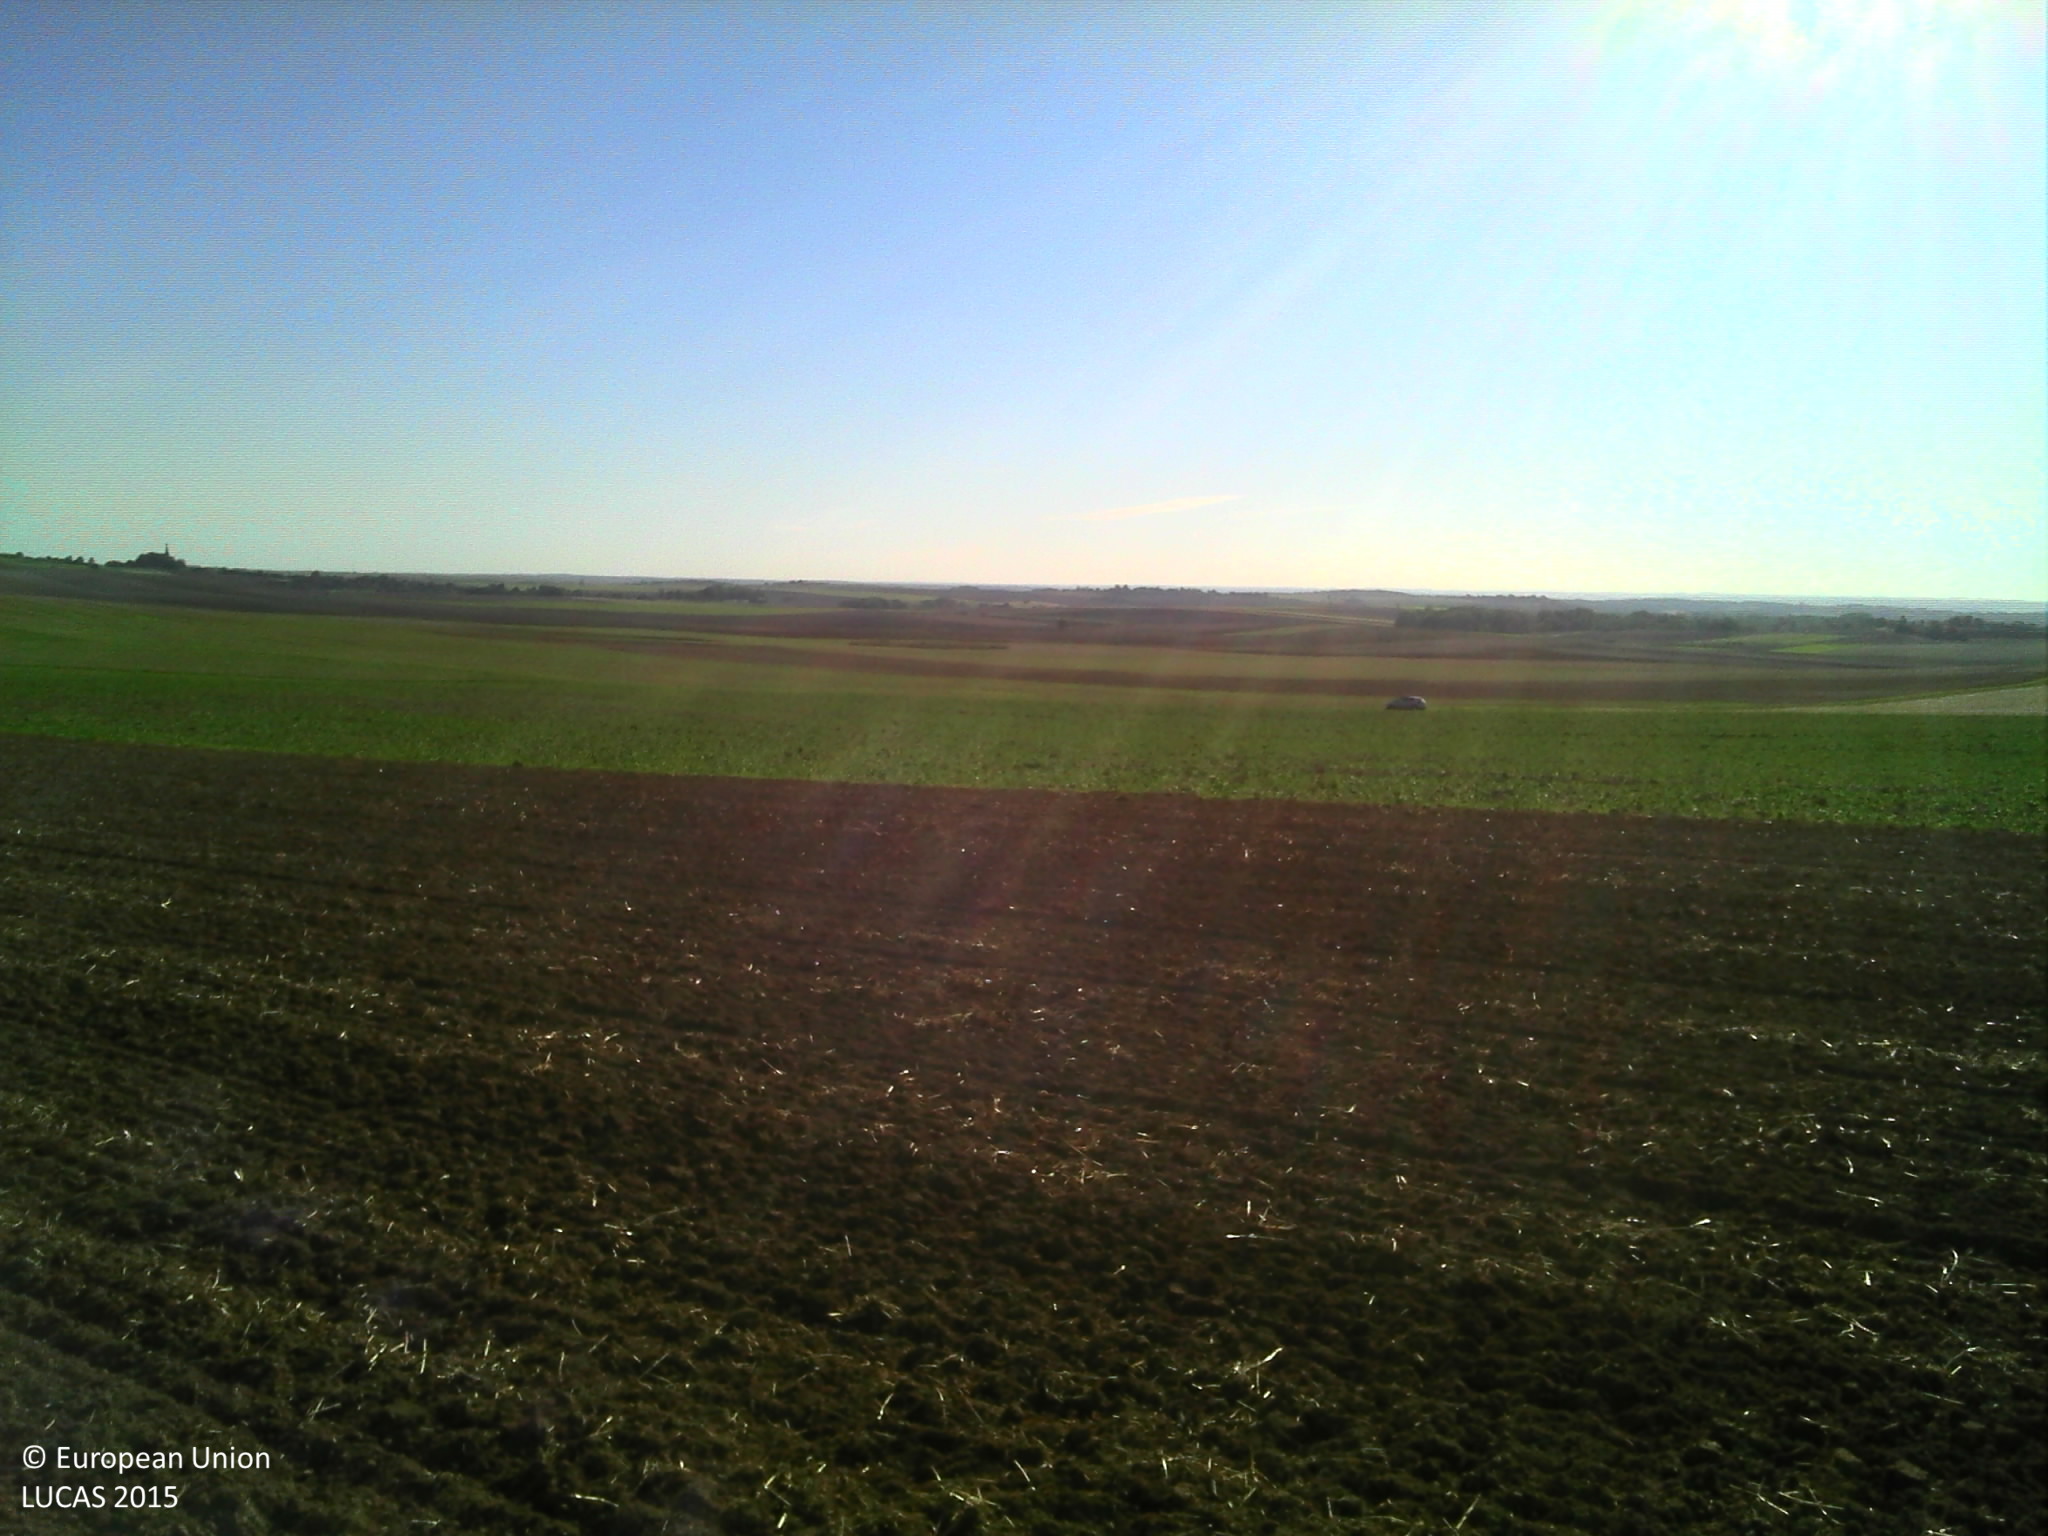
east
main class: Cropland
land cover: Common wheat
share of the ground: 10 - 25 %
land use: Agriculture (excluding fallow land and kitchen gardens)
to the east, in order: Common wheat; Dry pulses; Grassland without tree/shrub cover
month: September
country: FR
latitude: 48.0855
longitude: 3.8071
